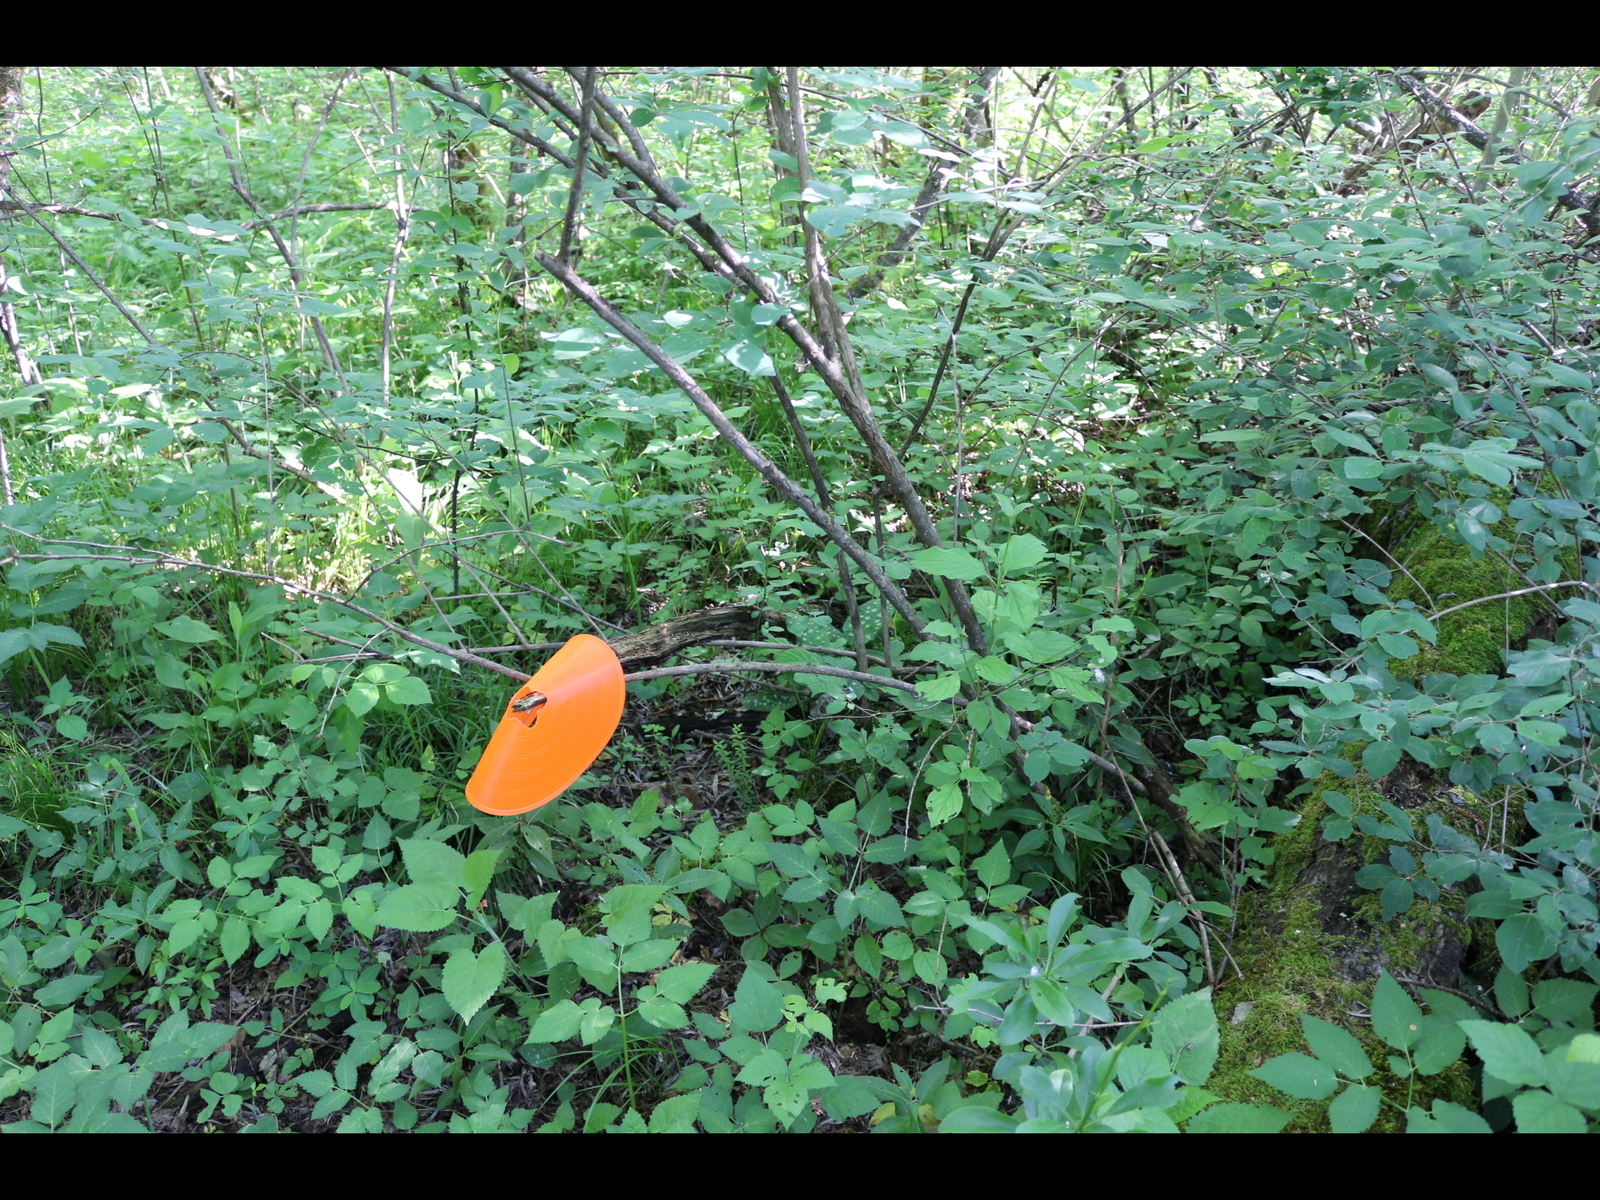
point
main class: Woodland
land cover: Broadleaved woodland
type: floodplain forest
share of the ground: > 75 %
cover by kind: broadleaved forest trees 50 %, shrubs 50 %
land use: Forestry
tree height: > 5 m
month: May
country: AT
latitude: 46.5389
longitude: 14.2090
